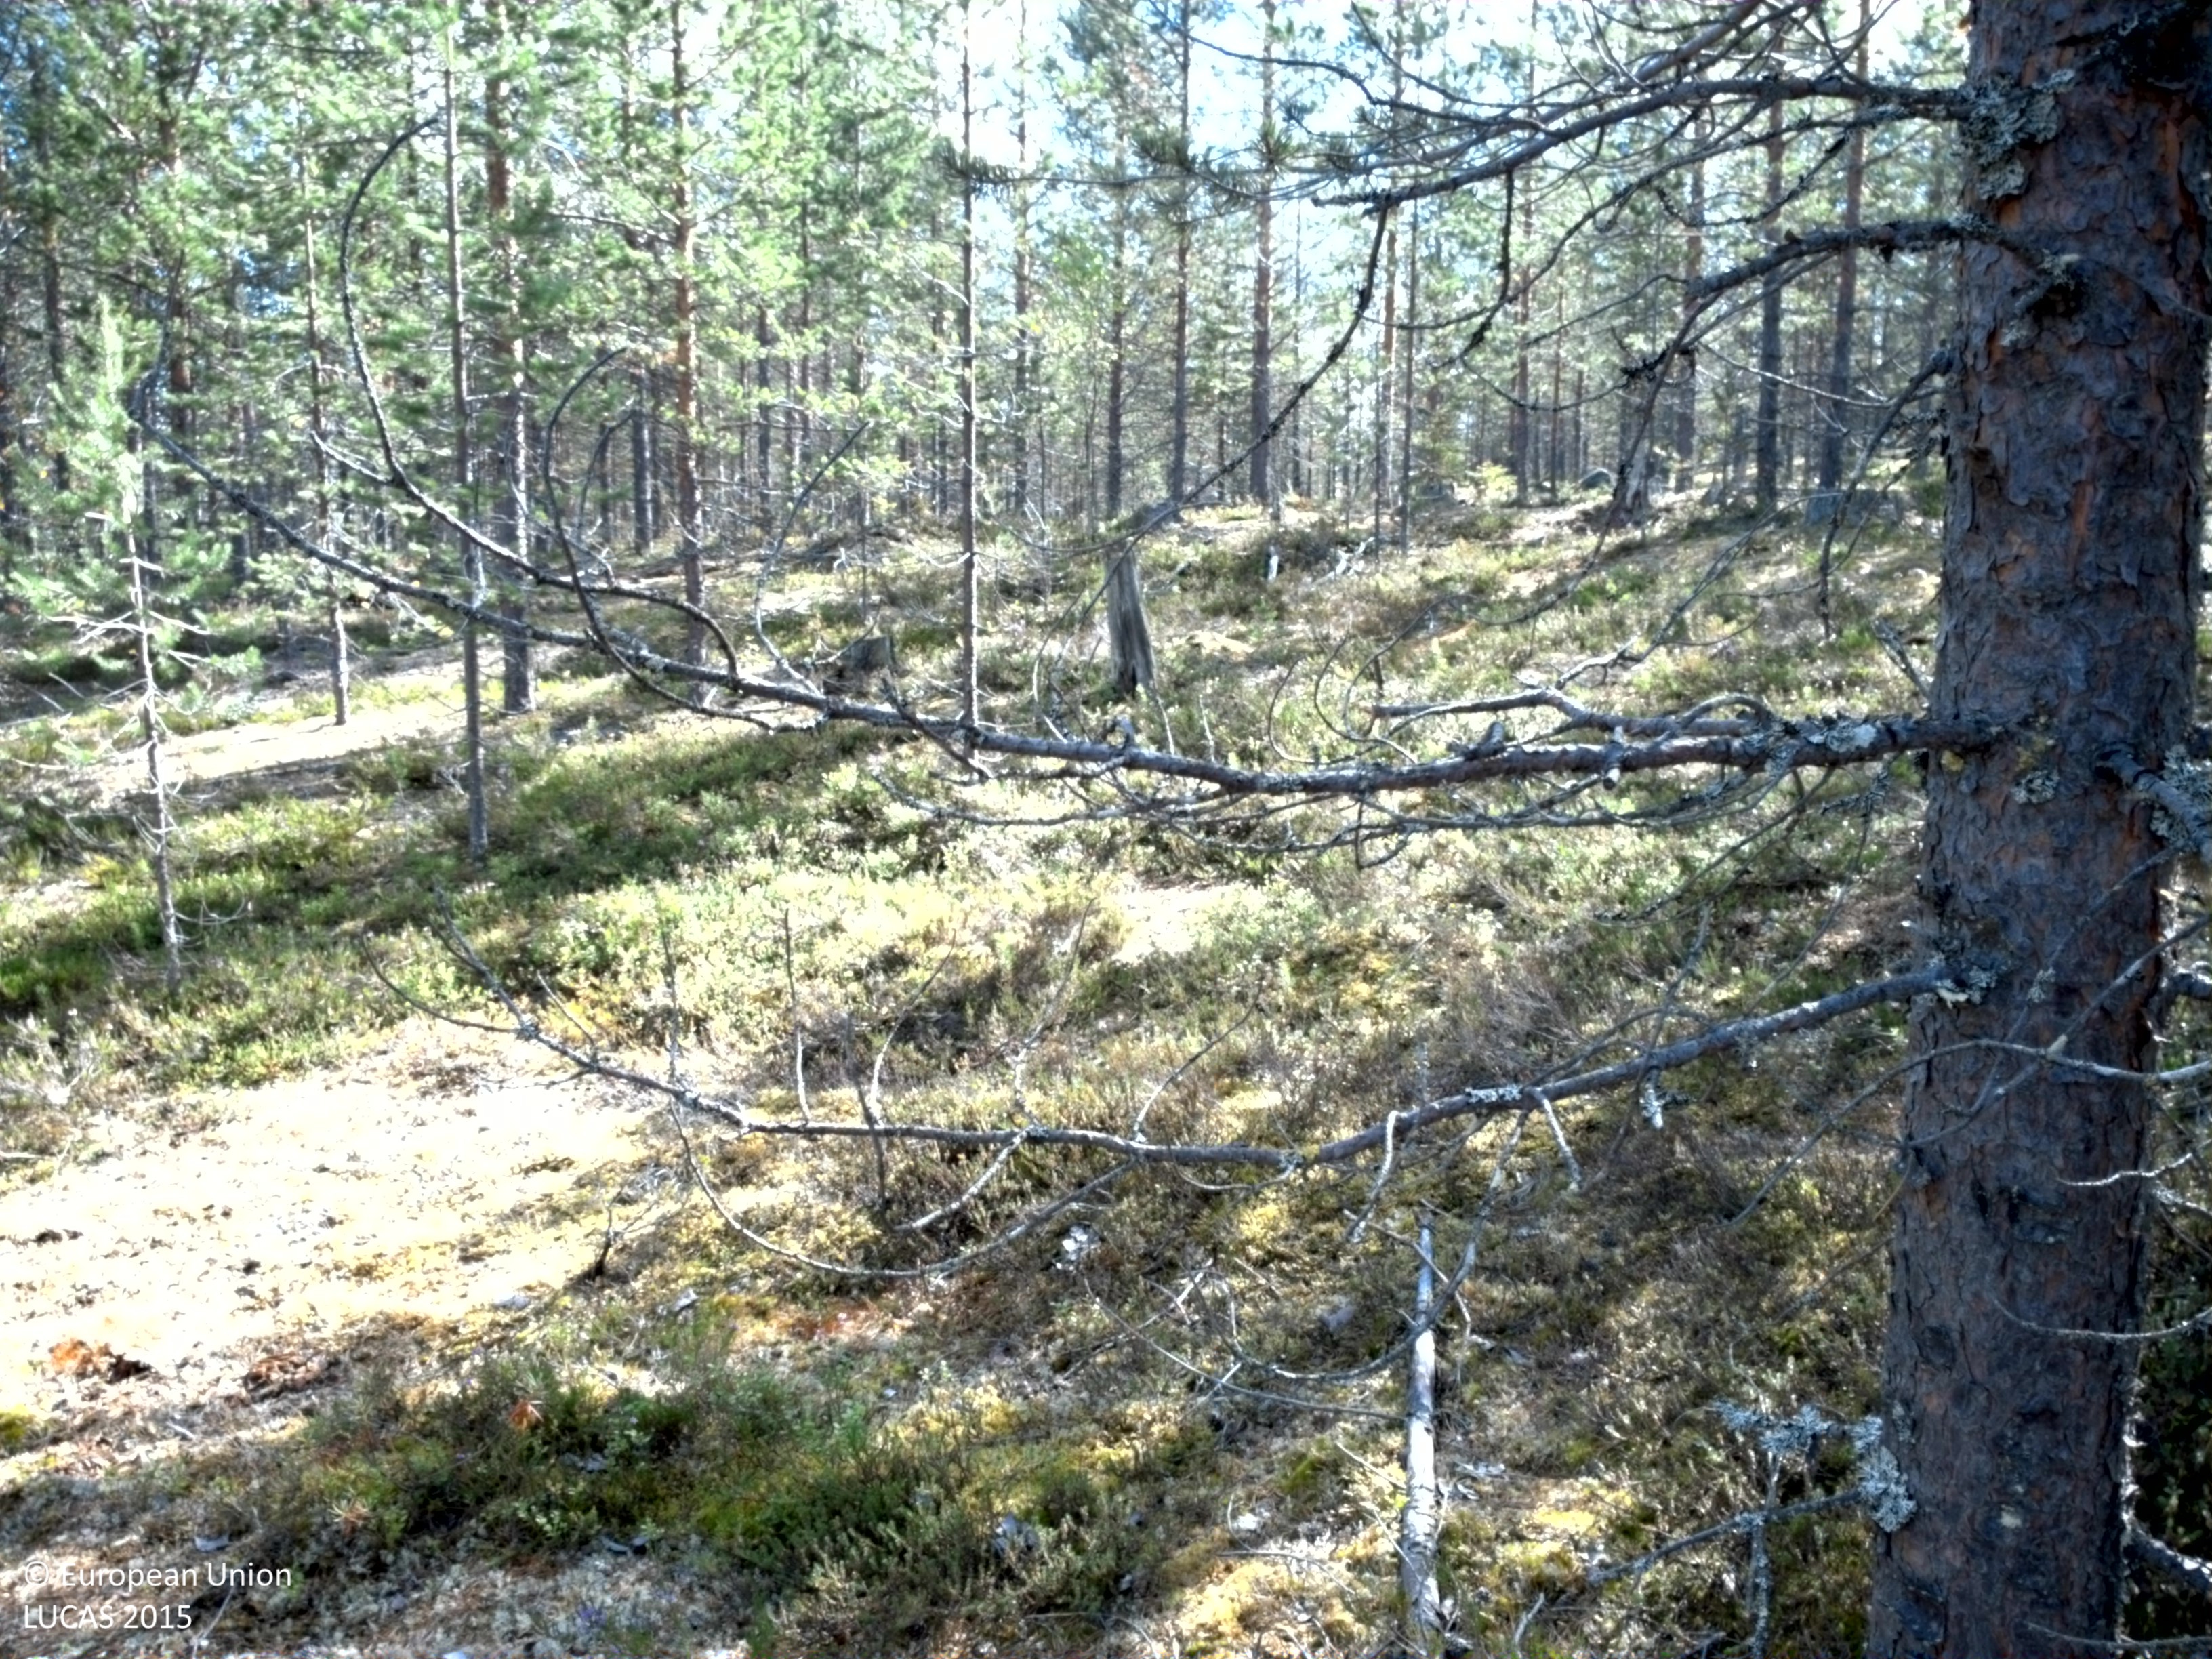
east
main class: Woodland
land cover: Pine dominated coniferous woodland
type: boreal forest
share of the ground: 25 - 50 %
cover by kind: shrubs 50 %, coniferous forest trees 35 %, lichens and mosses 15 %
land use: Forestry
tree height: > 5 m
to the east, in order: Pine dominated coniferous woodland; Pine dominated mixed woodland; Other coniferous woodland; Peatbogs
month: August
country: SE
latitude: 66.1926
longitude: 22.2950
